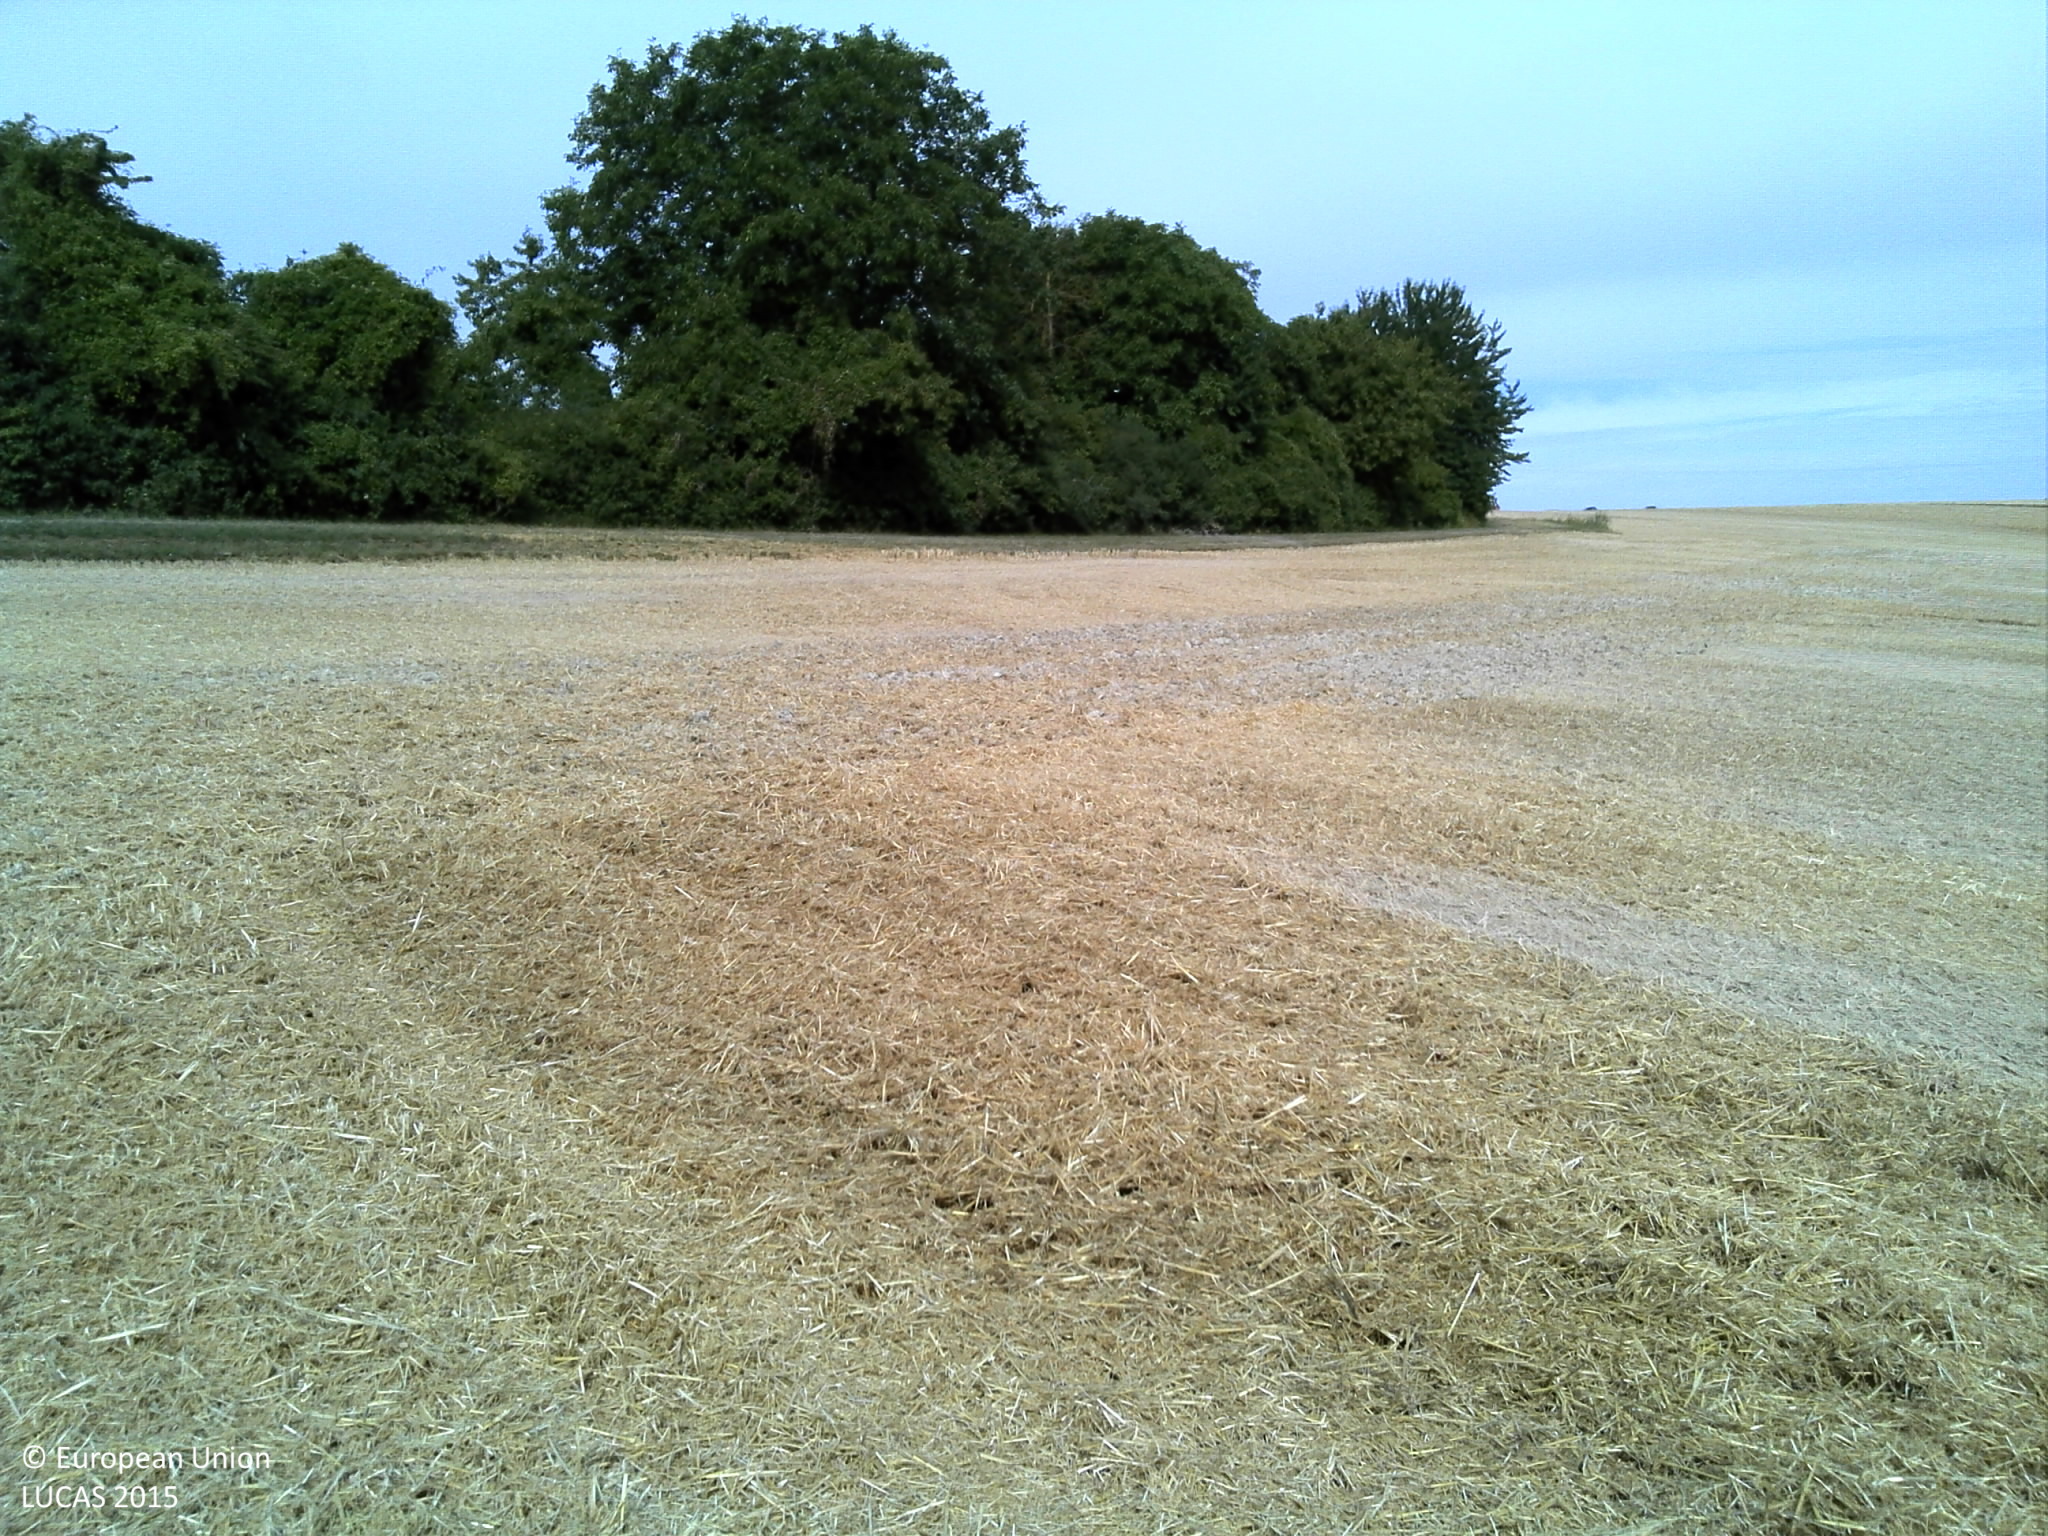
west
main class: Cropland
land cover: Common wheat
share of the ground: > 75 %
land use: Agriculture (excluding fallow land and kitchen gardens)
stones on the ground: < 10 %
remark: Harvested field
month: July
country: FR
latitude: 48.6493
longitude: 4.5814
